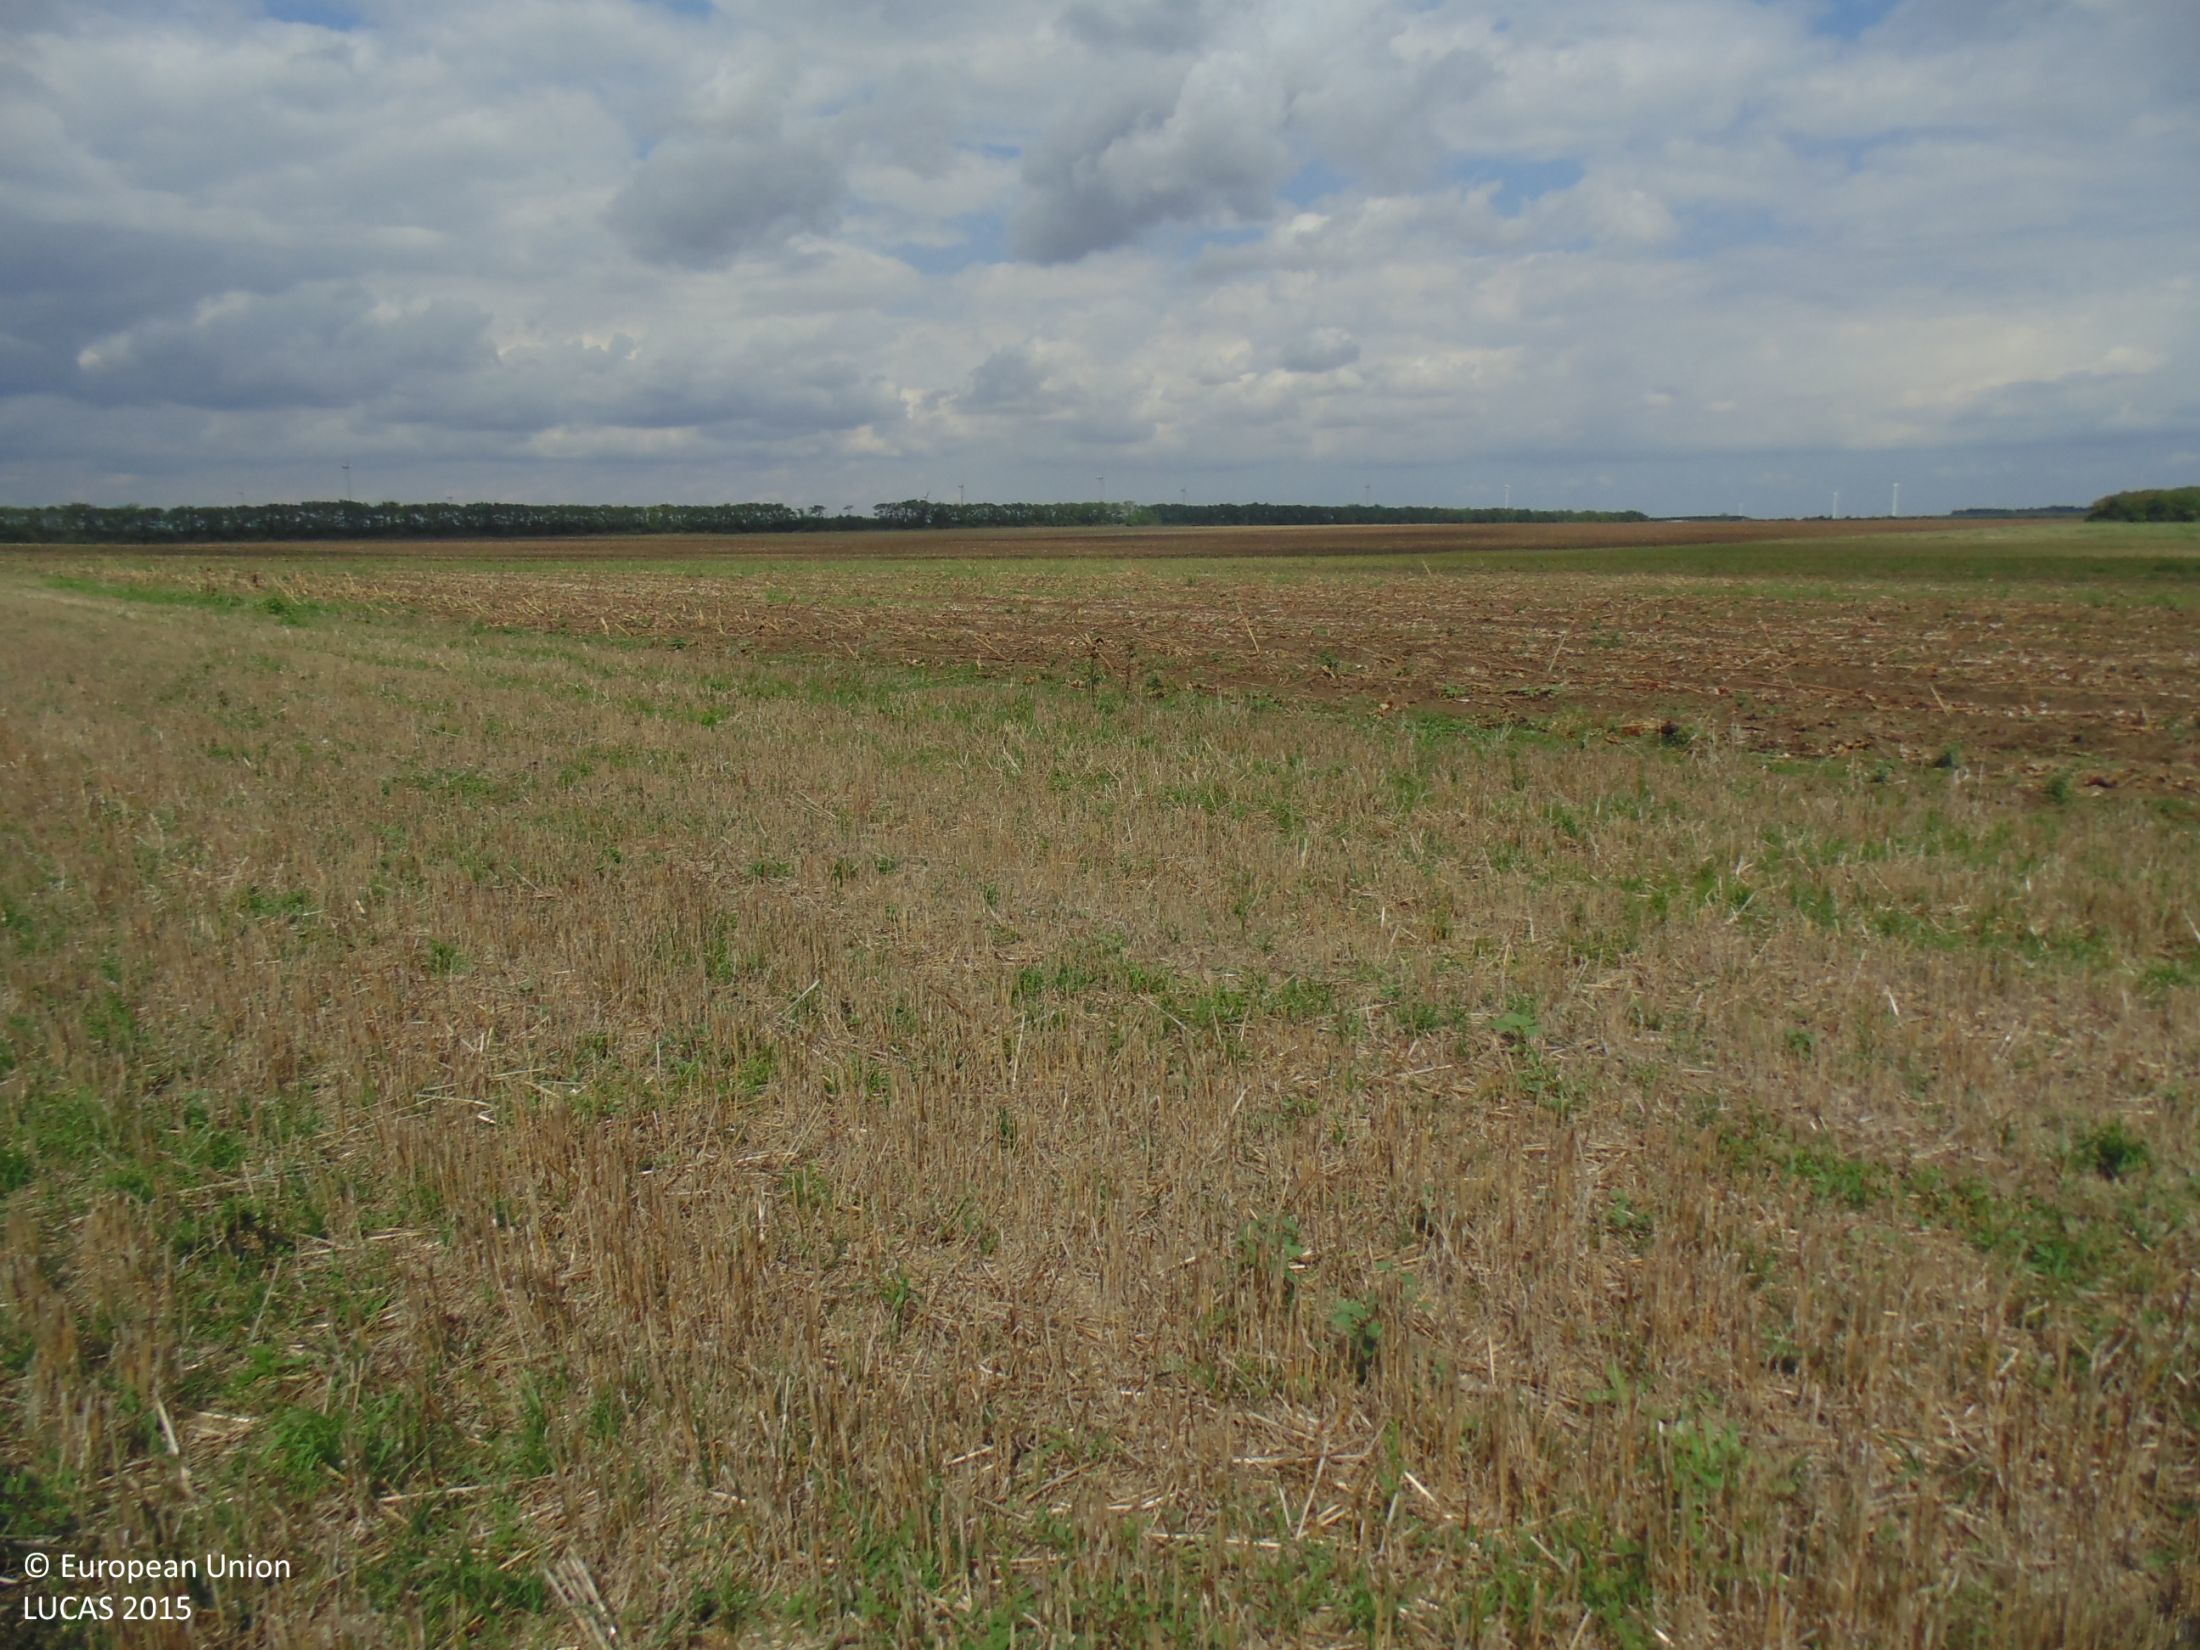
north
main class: Cropland
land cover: Common wheat
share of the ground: 25 - 50 %
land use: Agriculture (excluding fallow land and kitchen gardens)
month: September
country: BG
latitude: 43.4127
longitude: 28.4736
